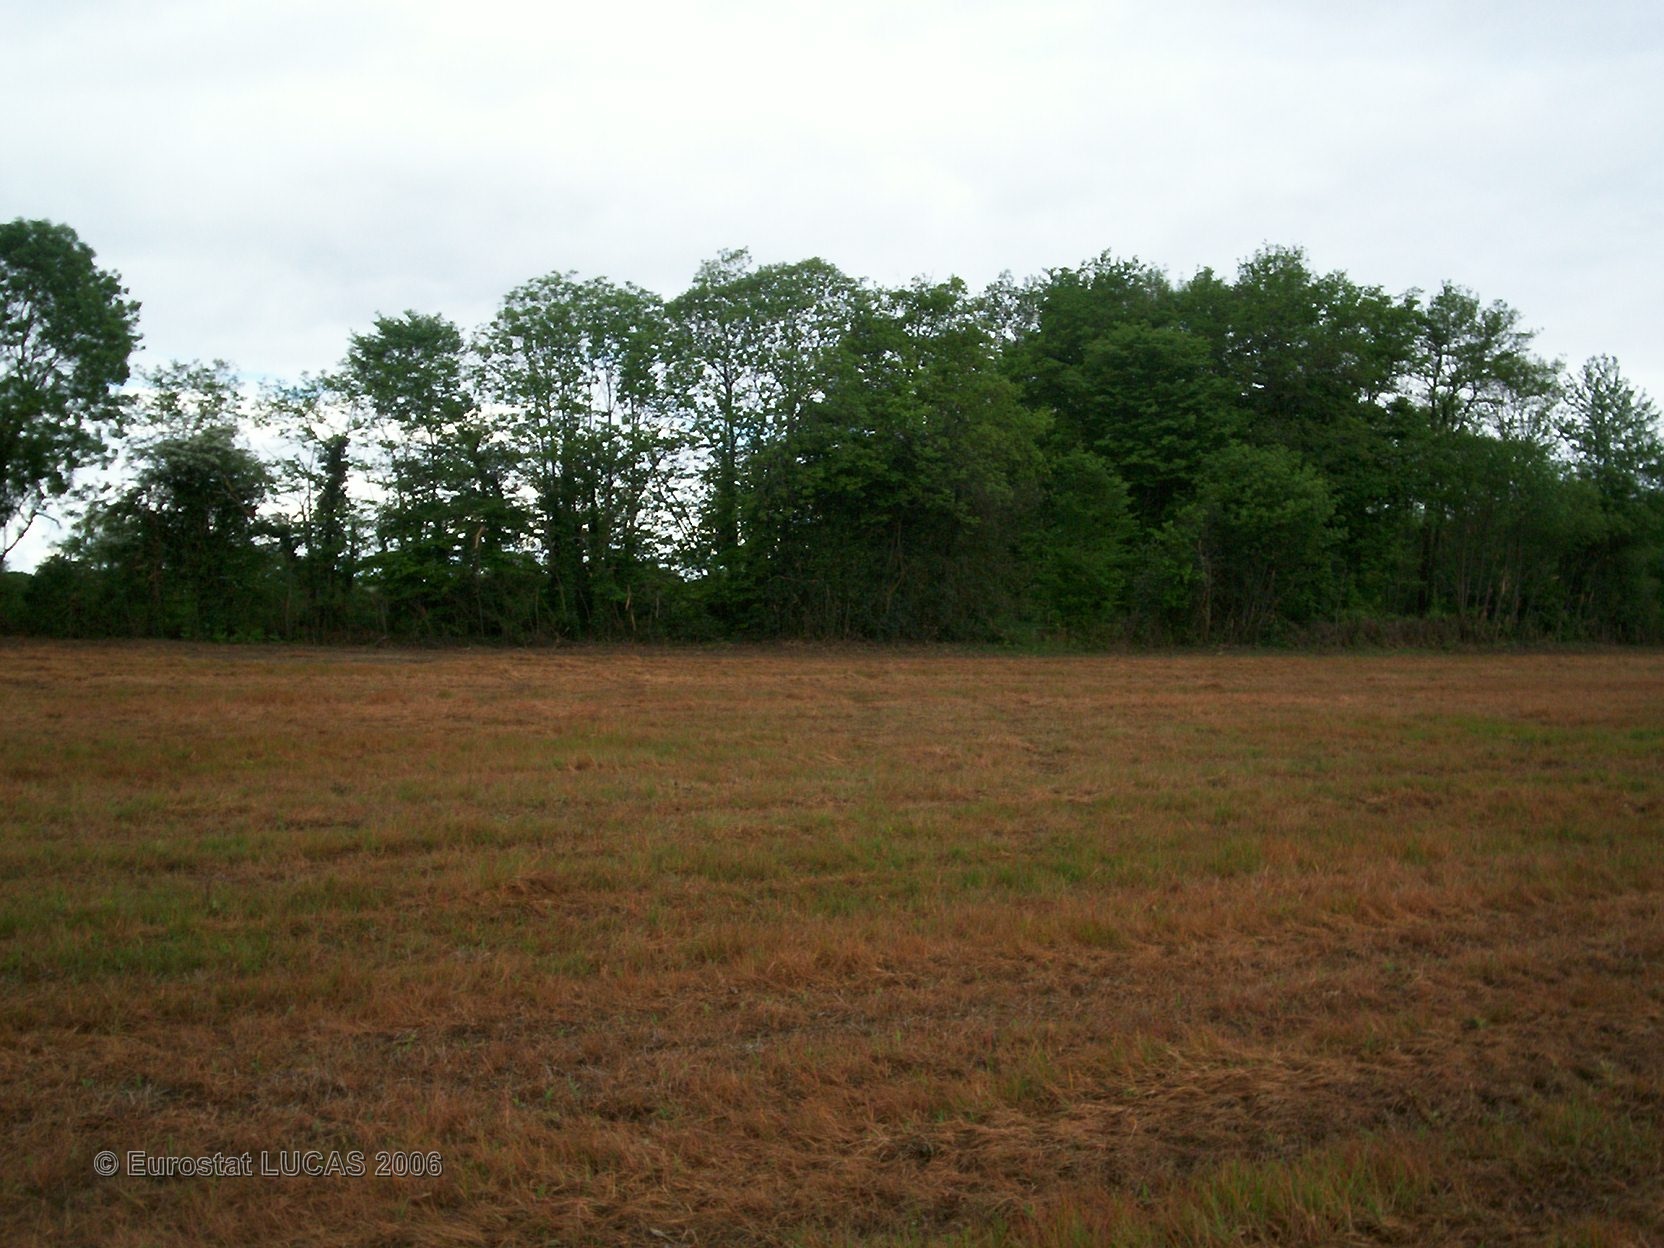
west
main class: Cropland
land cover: Maize
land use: Agriculture (excluding fallow land and kitchen gardens)
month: May
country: FR
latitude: 46.0174
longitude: 0.4910
